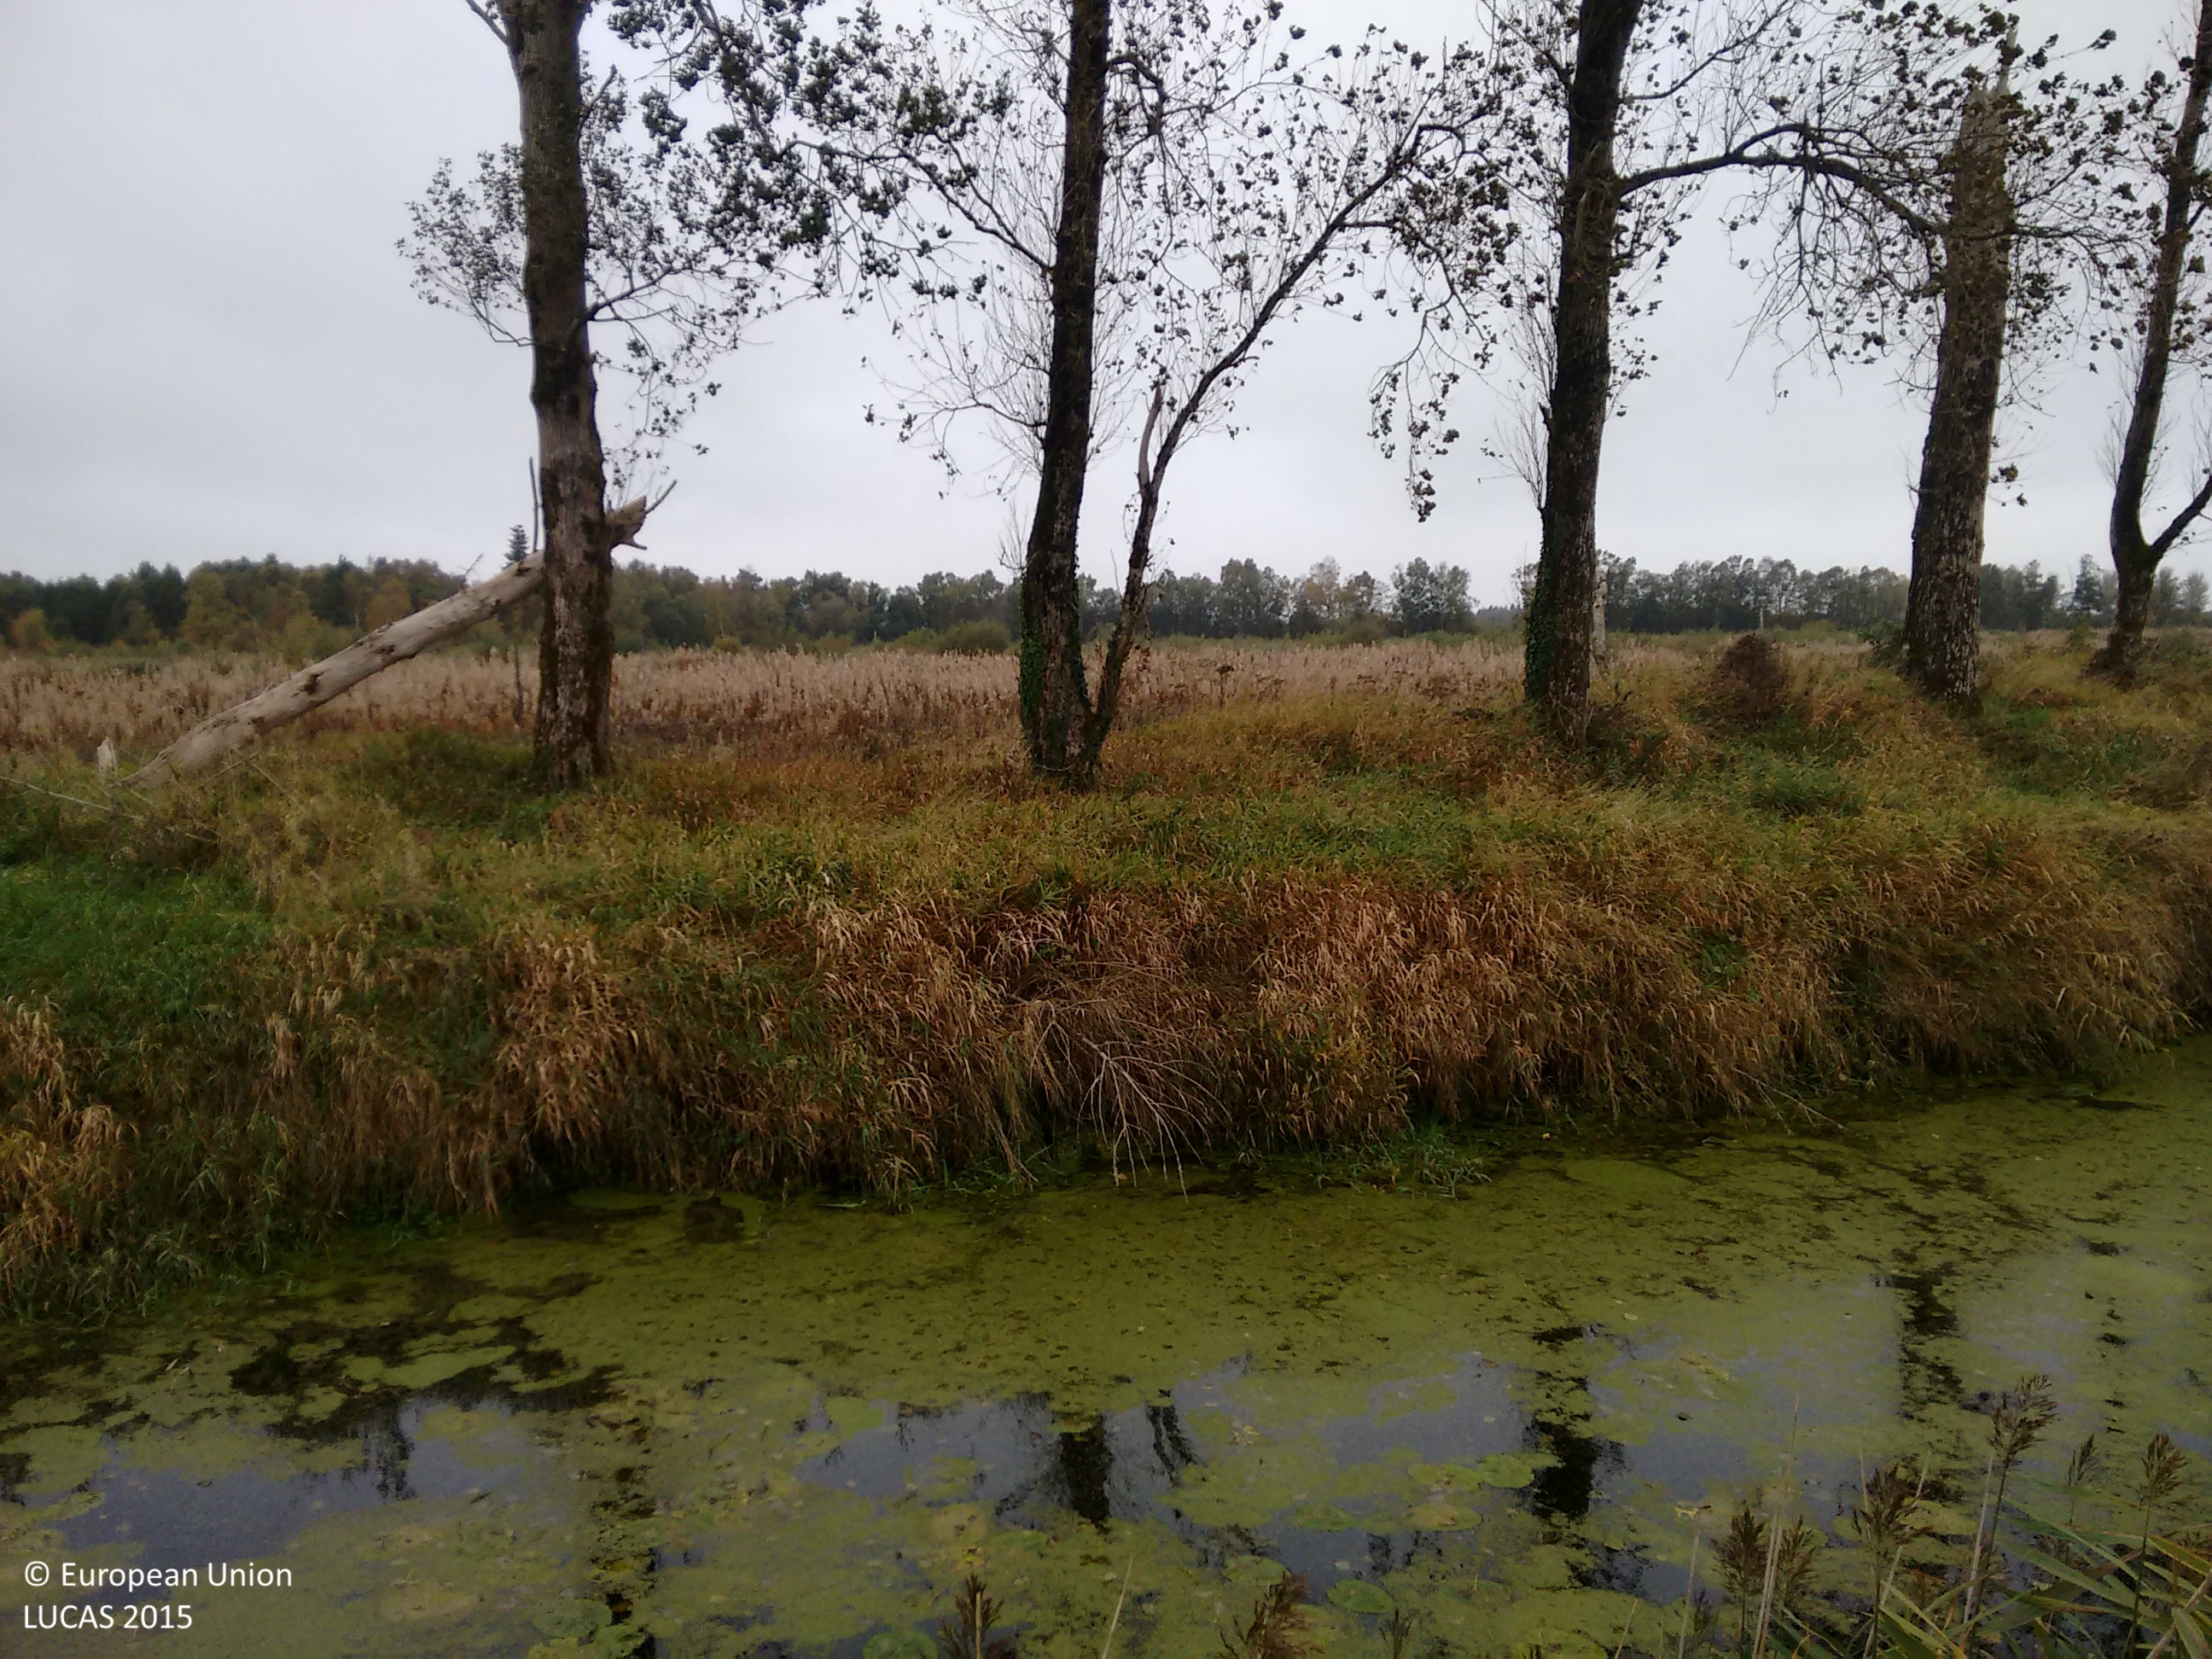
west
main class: Grassland
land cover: Grassland without tree/shrub cover
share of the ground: > 75 %
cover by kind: herbaceous plants 100 %
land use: Semi-natural and natural areas not in use
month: October
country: IE
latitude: 52.7171
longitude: -7.6472
